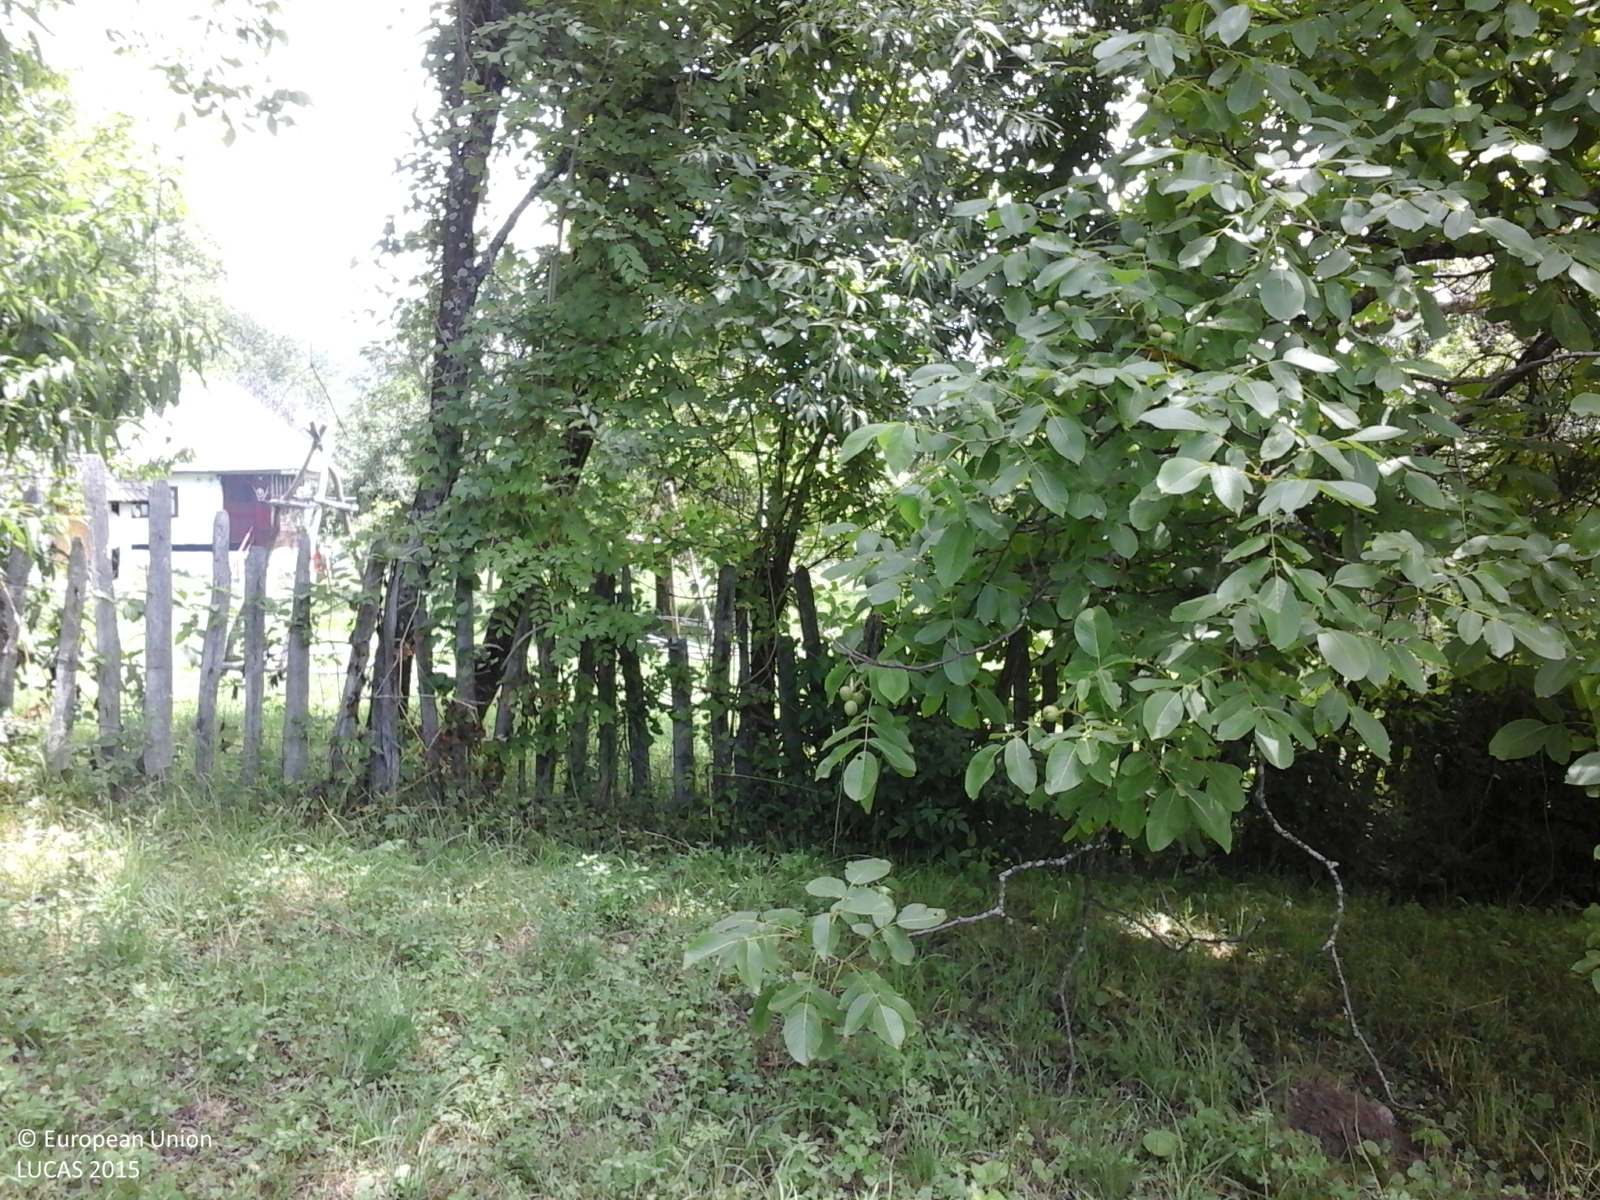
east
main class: Cropland
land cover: Apple fruit
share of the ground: > 75 %
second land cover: Grassland without tree/shrub cover
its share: > 75 %
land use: Agriculture (excluding fallow land and kitchen gardens)
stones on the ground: < 10 %
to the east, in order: Apple fruit; Grassland without tree/shrub cover; Fences; Apple fruit; Permanent crops (only in case pi); Grassland without tree/shrub cover; Permanent crops (only in case pi); Grassland with sparse tree/shrub cover; Ditches and canals; Tracks; Grass margins; Fences; Lines of trees; Grassland without tree/shrub cover; Grassland with sparse tree/shrub cover
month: July
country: RO
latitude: 45.3405
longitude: 24.6161
